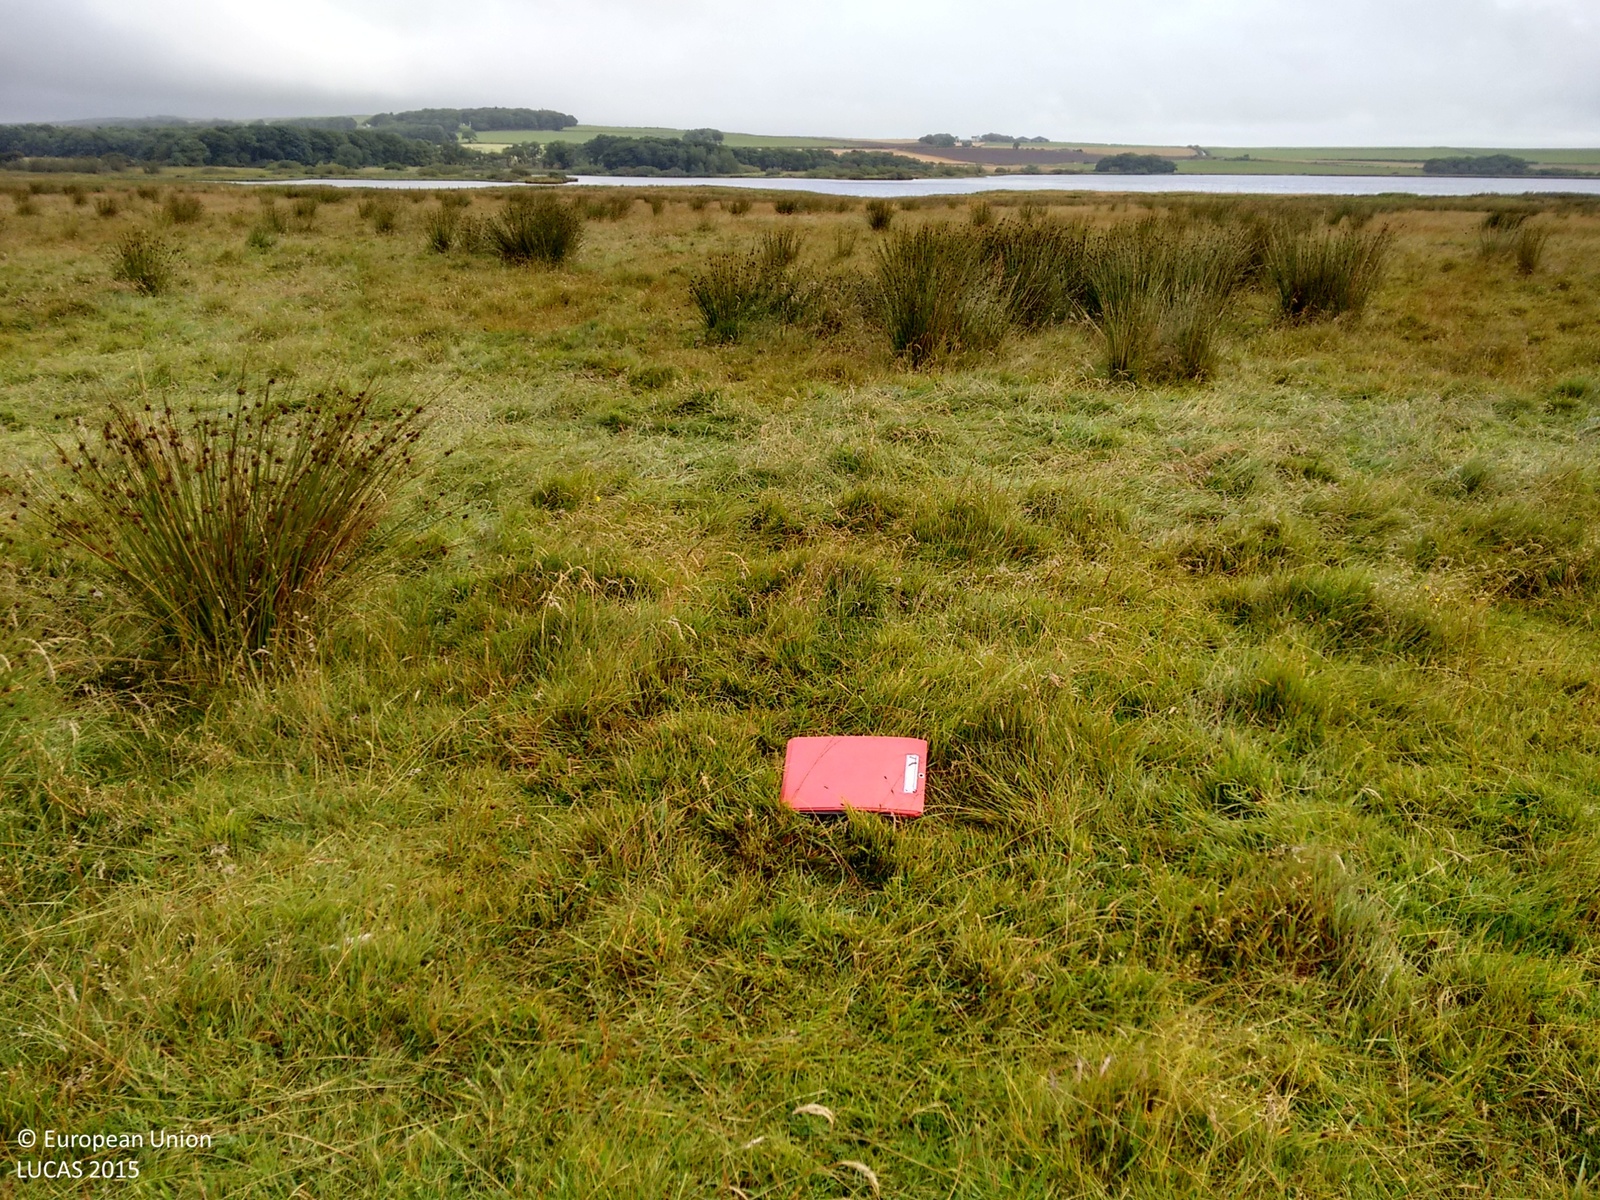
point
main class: Grassland
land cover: Grassland without tree/shrub cover
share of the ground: > 75 %
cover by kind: herbaceous plants 100 %
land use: Agriculture (excluding fallow land and kitchen gardens)
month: September
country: GB
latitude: 58.5130
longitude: -3.4003
